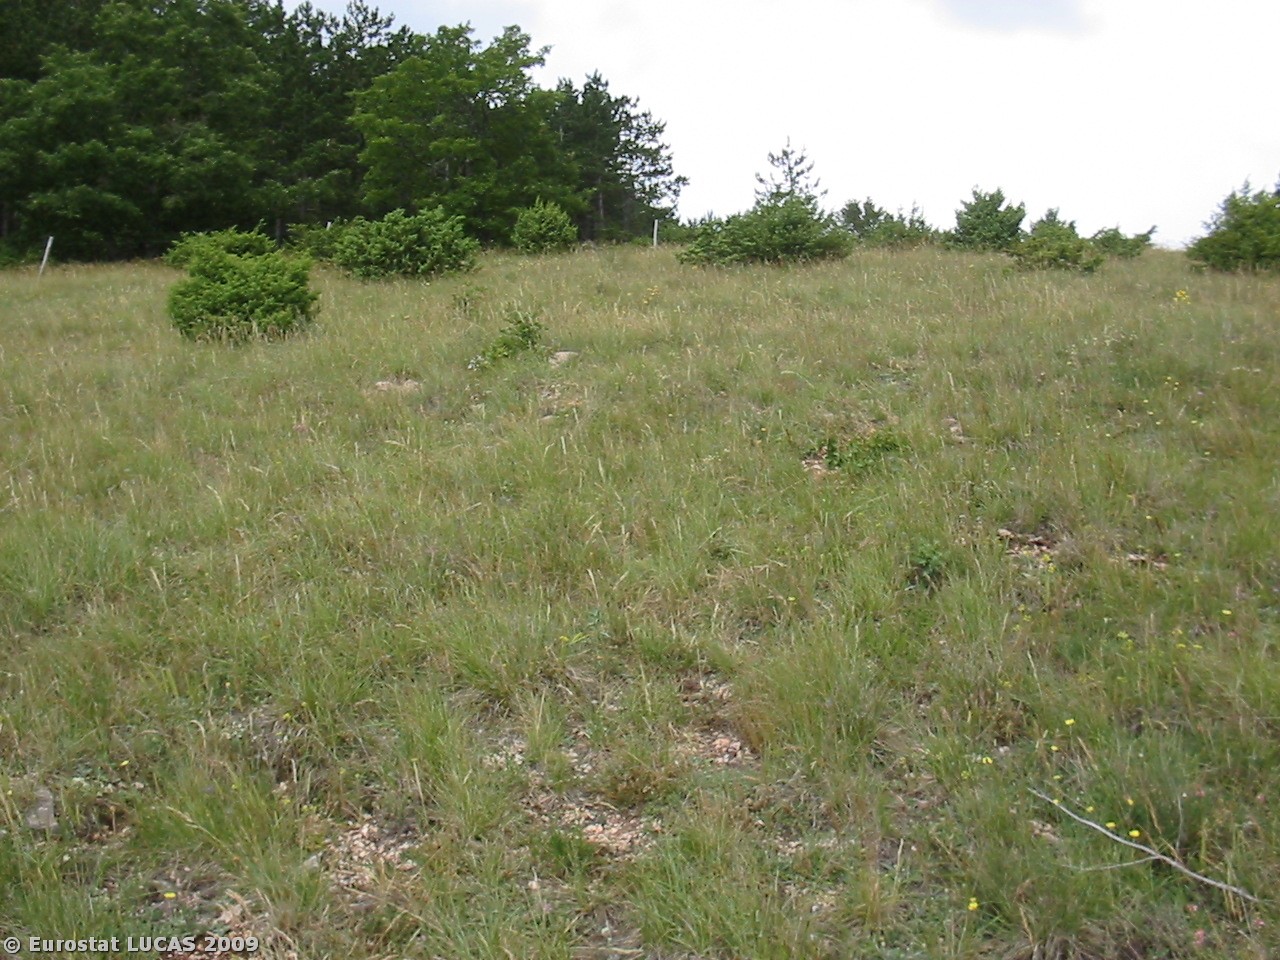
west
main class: Grassland
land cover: Grassland with sparse tree/shrub cover
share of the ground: > 75 %
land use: Agriculture (excluding fallow land and kitchen gardens)
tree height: < 5 m
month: June
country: IT
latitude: 42.9927
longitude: 12.8740
